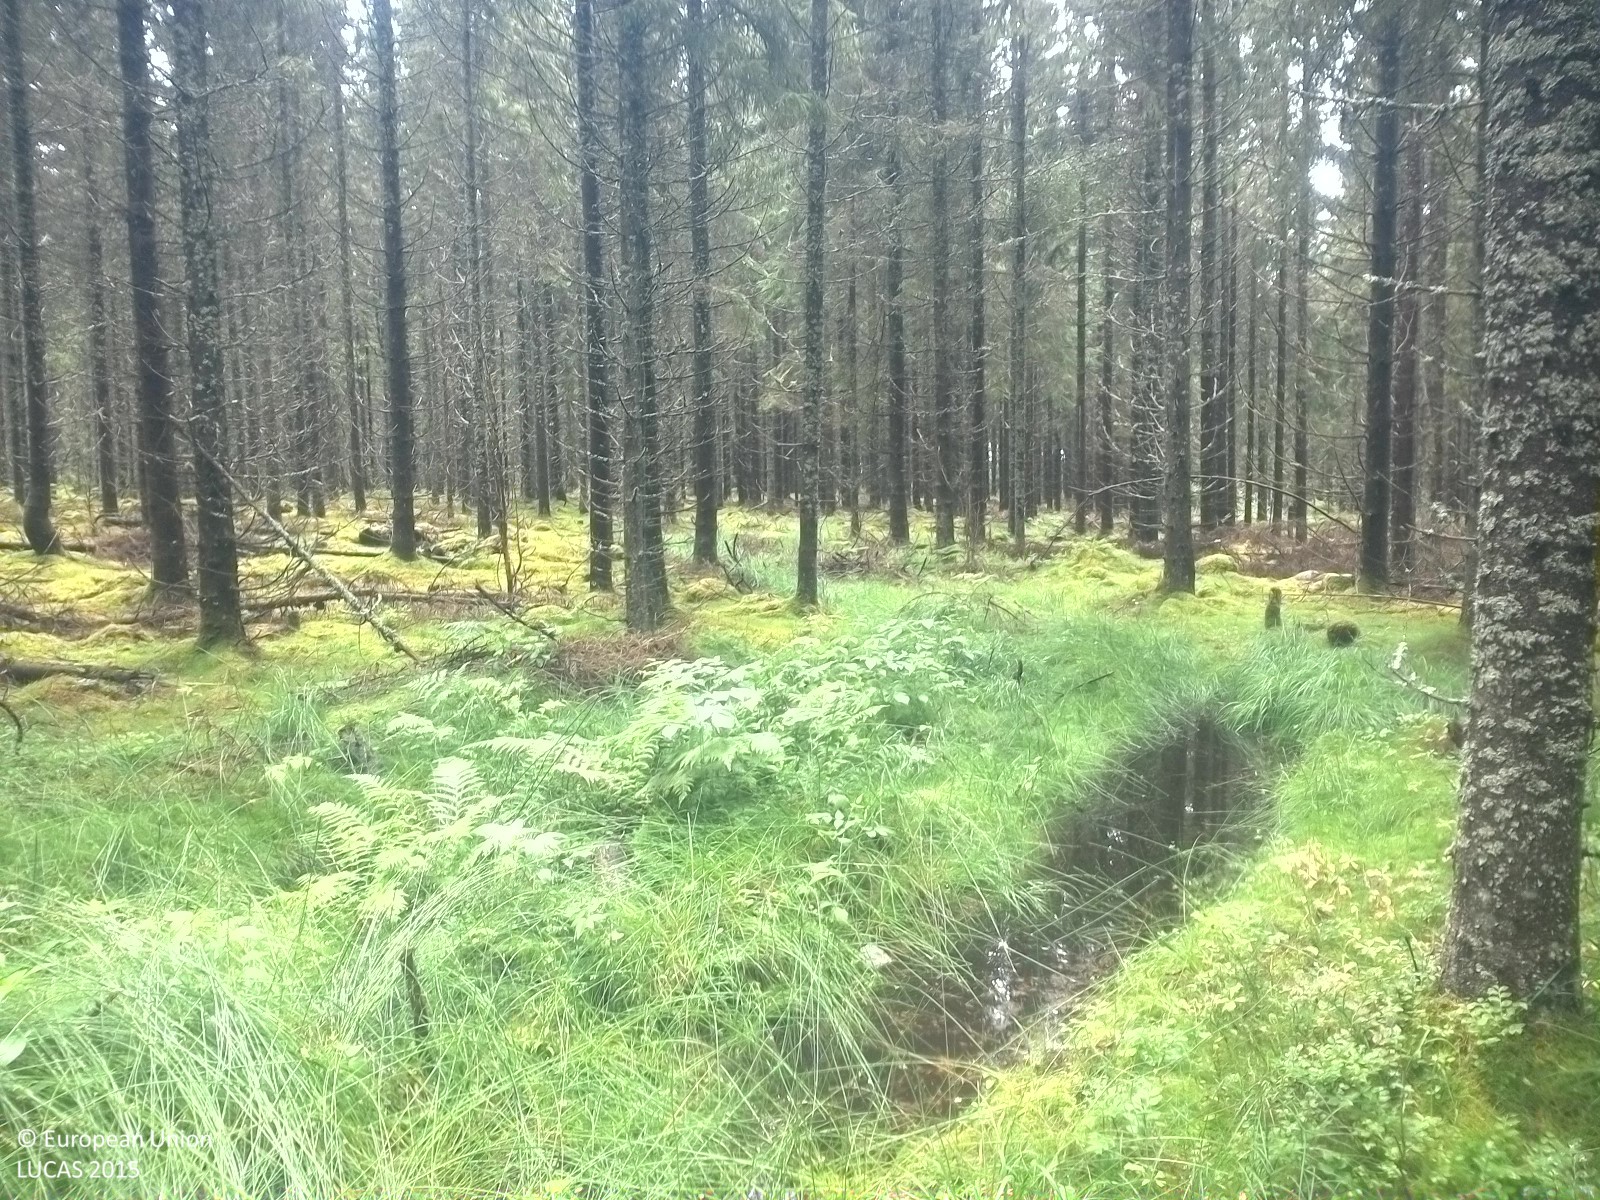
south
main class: Woodland
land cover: Spruce dominated coniferous woodland
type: boreal forest
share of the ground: 25 - 50 %
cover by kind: coniferous forest trees 40 %, lichens and mosses 35 %, herbaceous plants 25 %
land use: Forestry
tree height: > 5 m
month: July
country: SE
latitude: 58.8604
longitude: 15.1420
